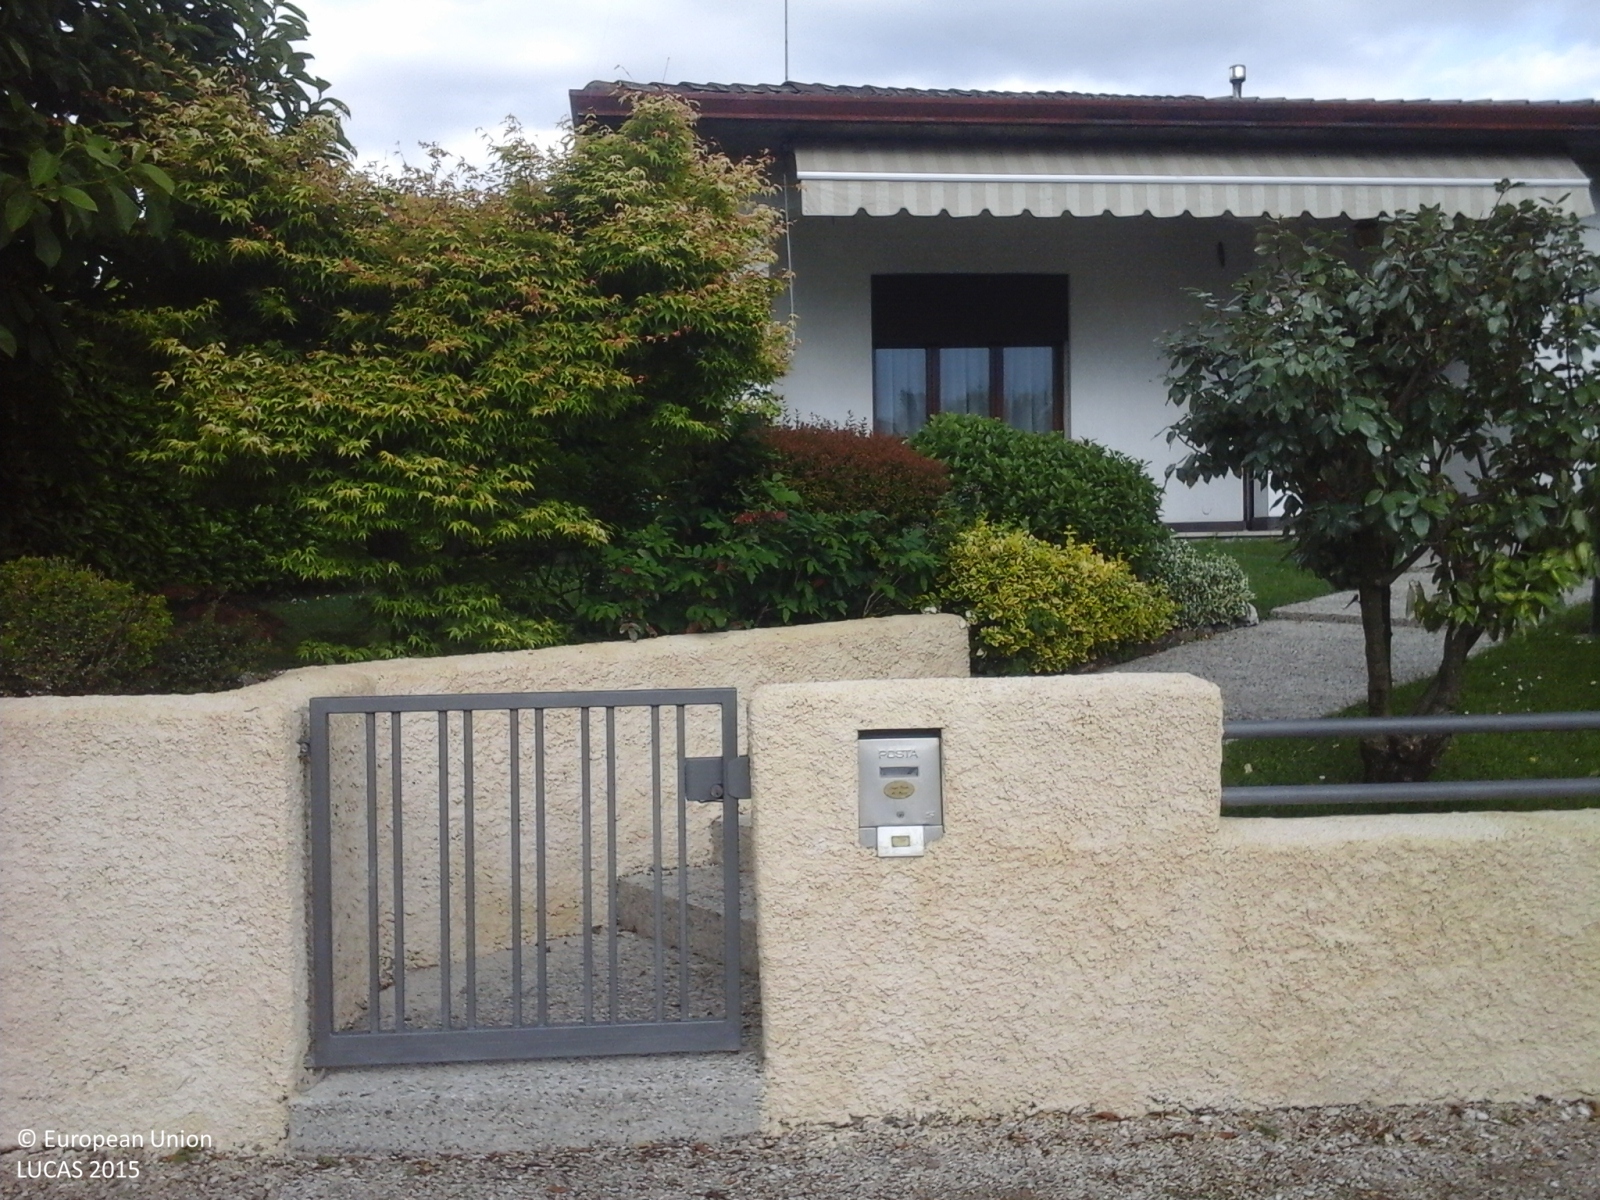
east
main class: Grassland
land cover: Grassland with sparse tree/shrub cover
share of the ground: > 75 %
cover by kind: herbaceous plants 95 %, broadleaved forest trees 5 %
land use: Residential
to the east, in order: Tracks; Grassland with sparse tree/shrub cover; Artificial constructions in urban areas; Common wheat; Artificial constructions in urban areas; Common wheat; Ditches and canals; Abandoned hedges; Ditches and canals; Abandoned hedges; Maize; Tracks; Maize
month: May
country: IT
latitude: 45.7061
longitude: 11.7570
